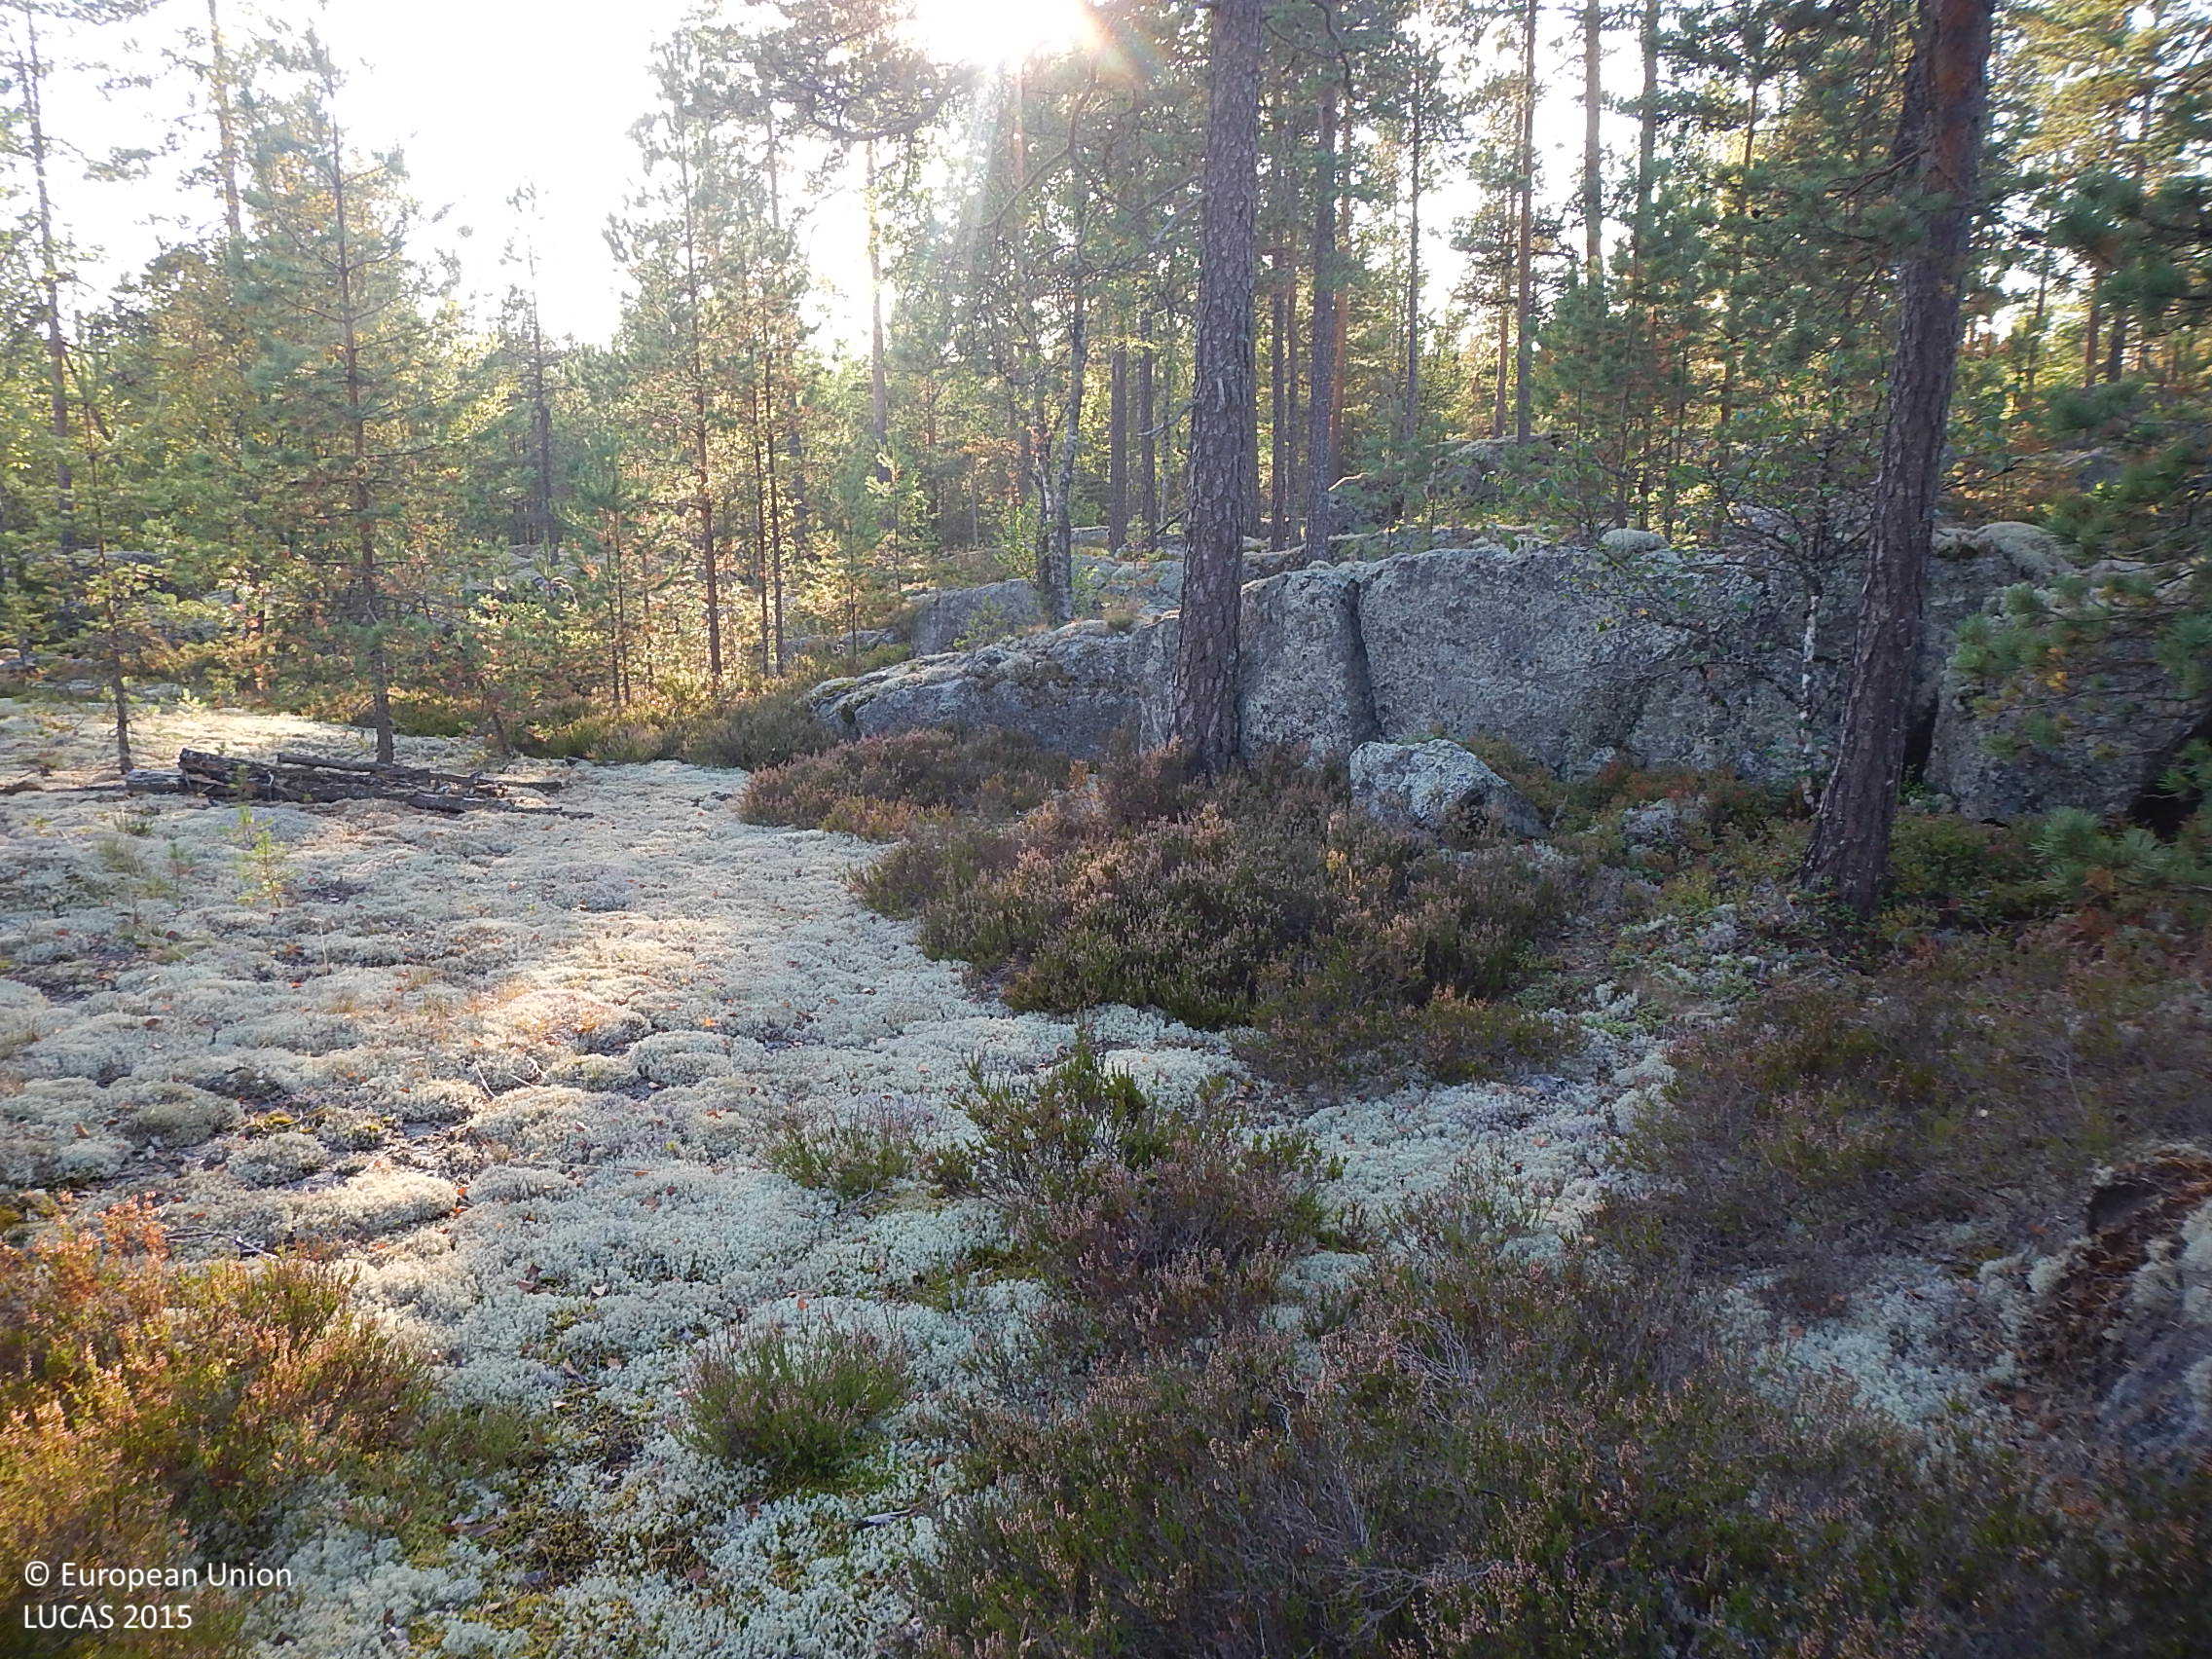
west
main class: Woodland
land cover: Pine dominated coniferous woodland
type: boreal forest
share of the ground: 25 - 50 %
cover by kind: coniferous forest trees 40 %, lichens and mosses 40 %, shrubs 10 %, consolidated bare surface 10 %
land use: Forestry
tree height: > 5 m
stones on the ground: < 10 %
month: September
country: FI
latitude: 61.6371
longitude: 22.6508
